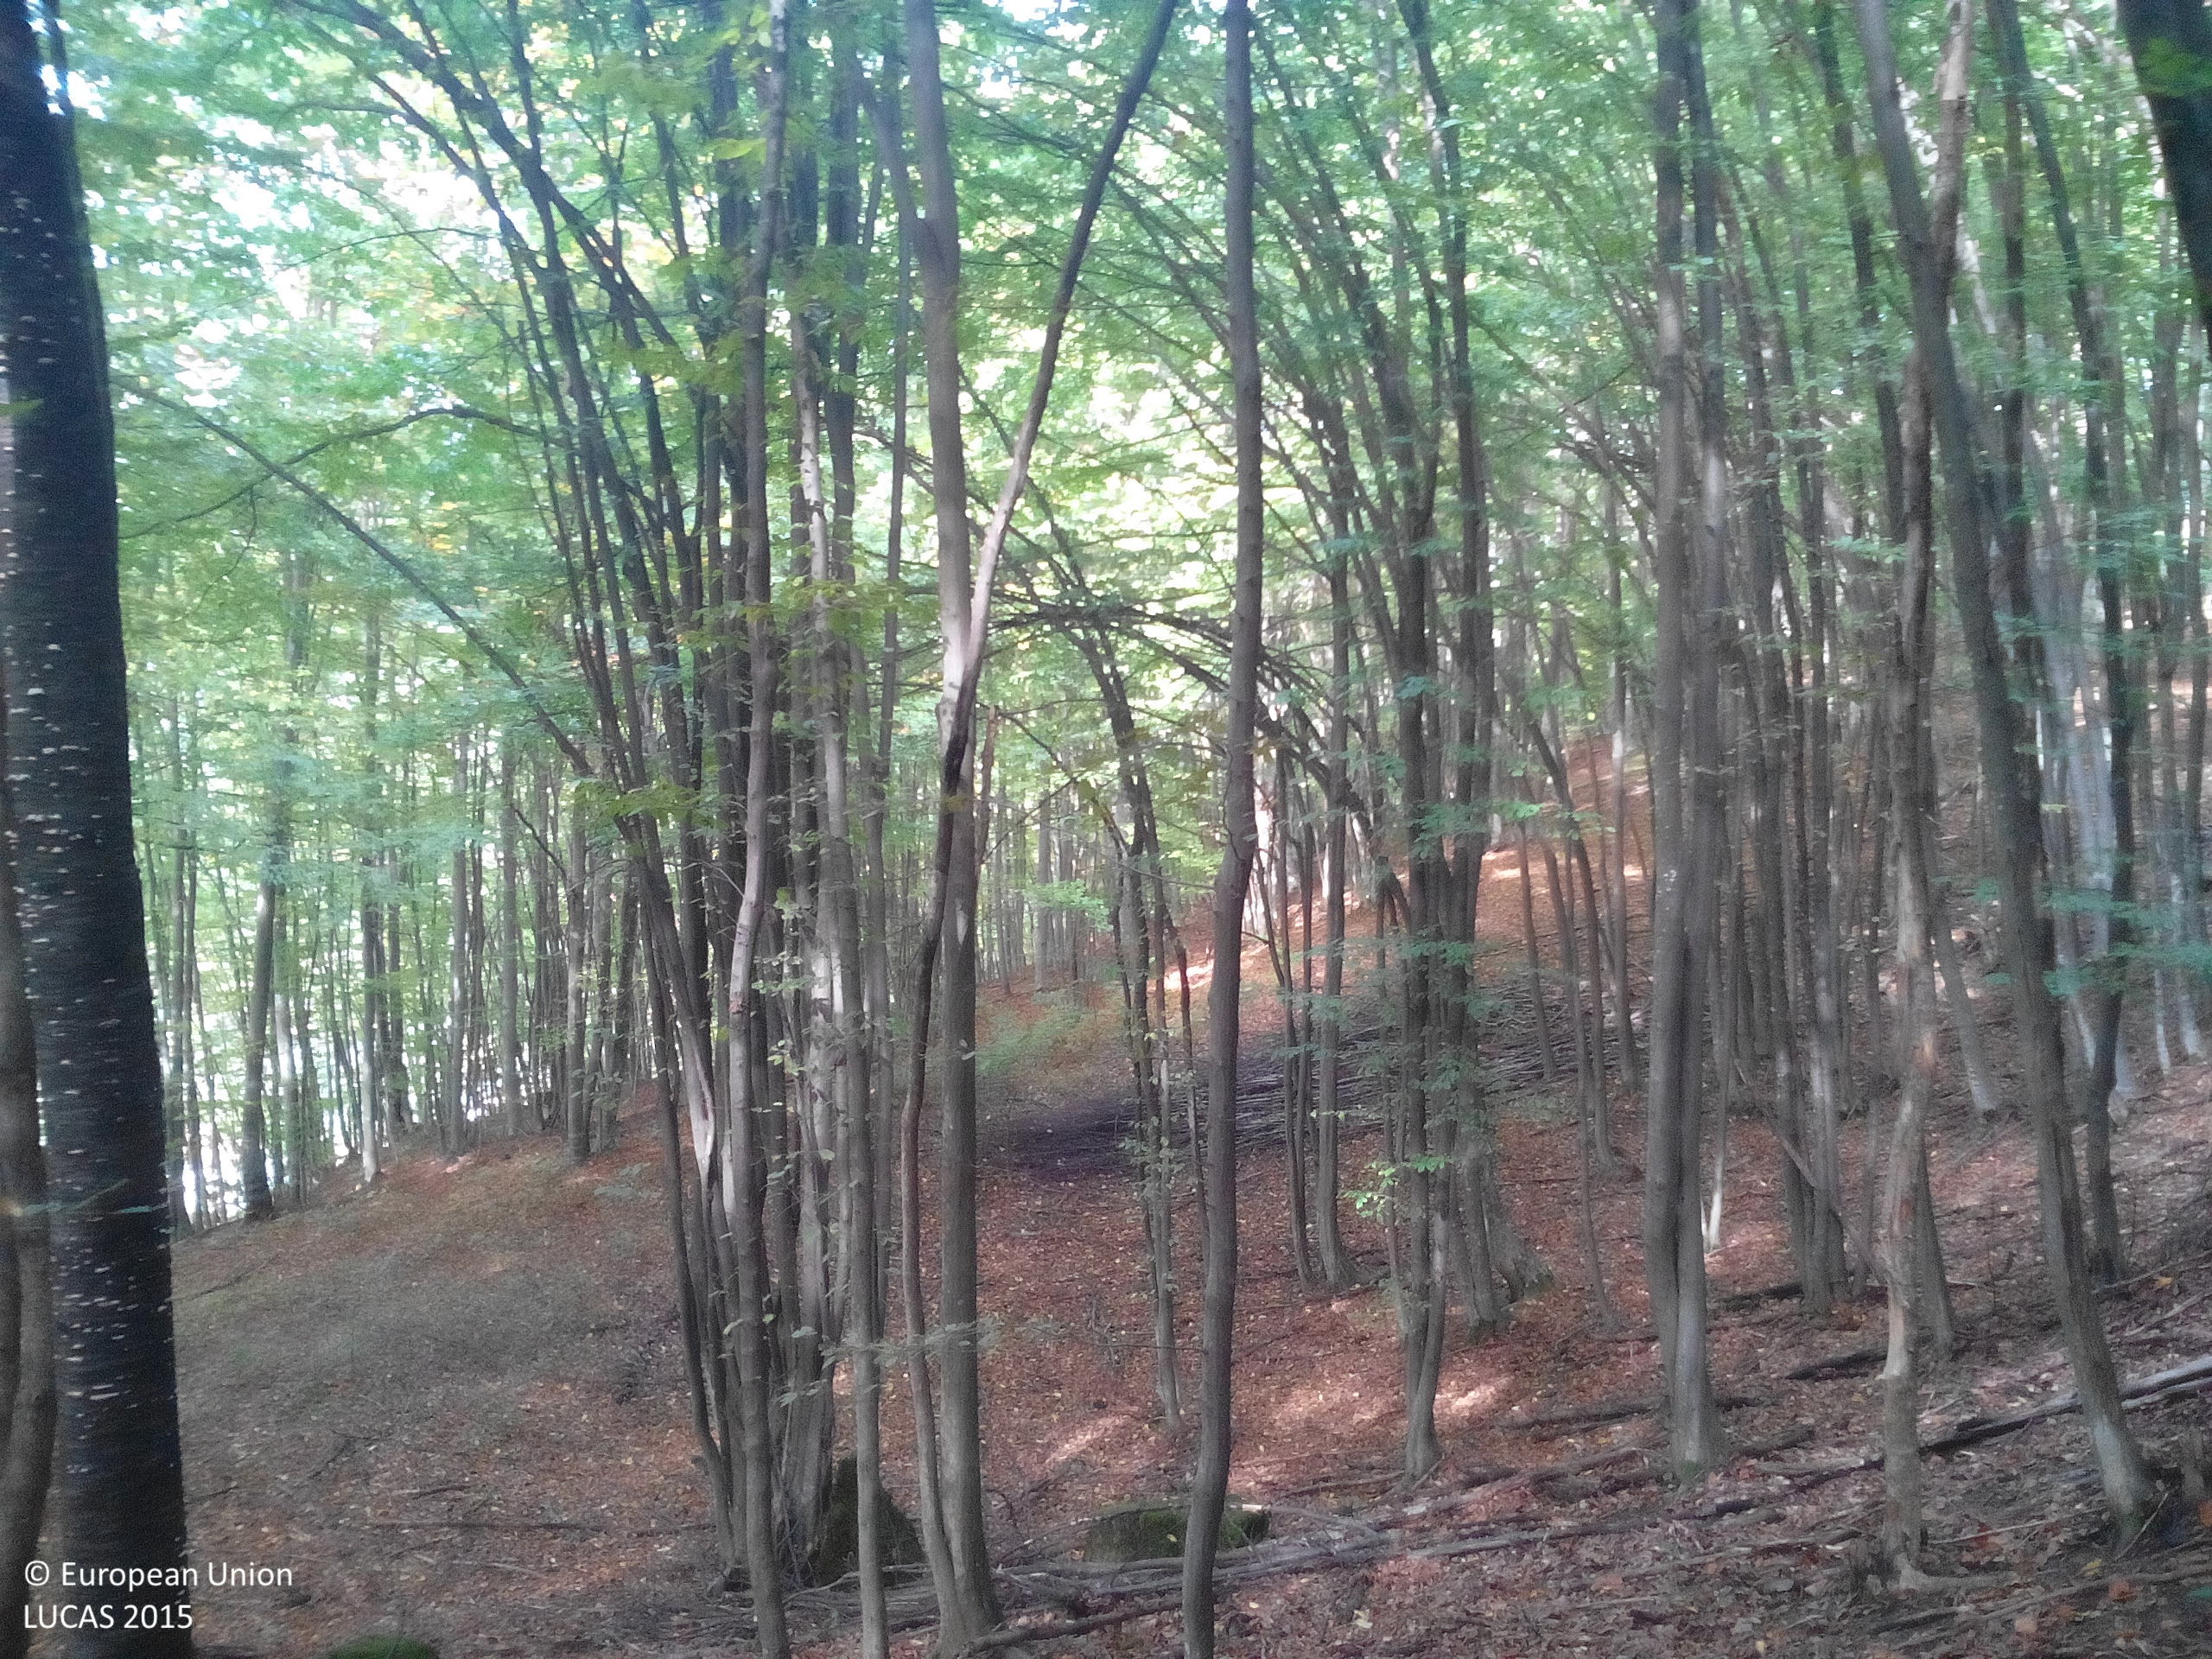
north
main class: Woodland
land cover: Broadleaved woodland
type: beech forest
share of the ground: > 75 %
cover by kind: broadleaved forest trees 100 %
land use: Forestry
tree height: > 5 m
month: October
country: BG
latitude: 42.8307
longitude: 24.3776
